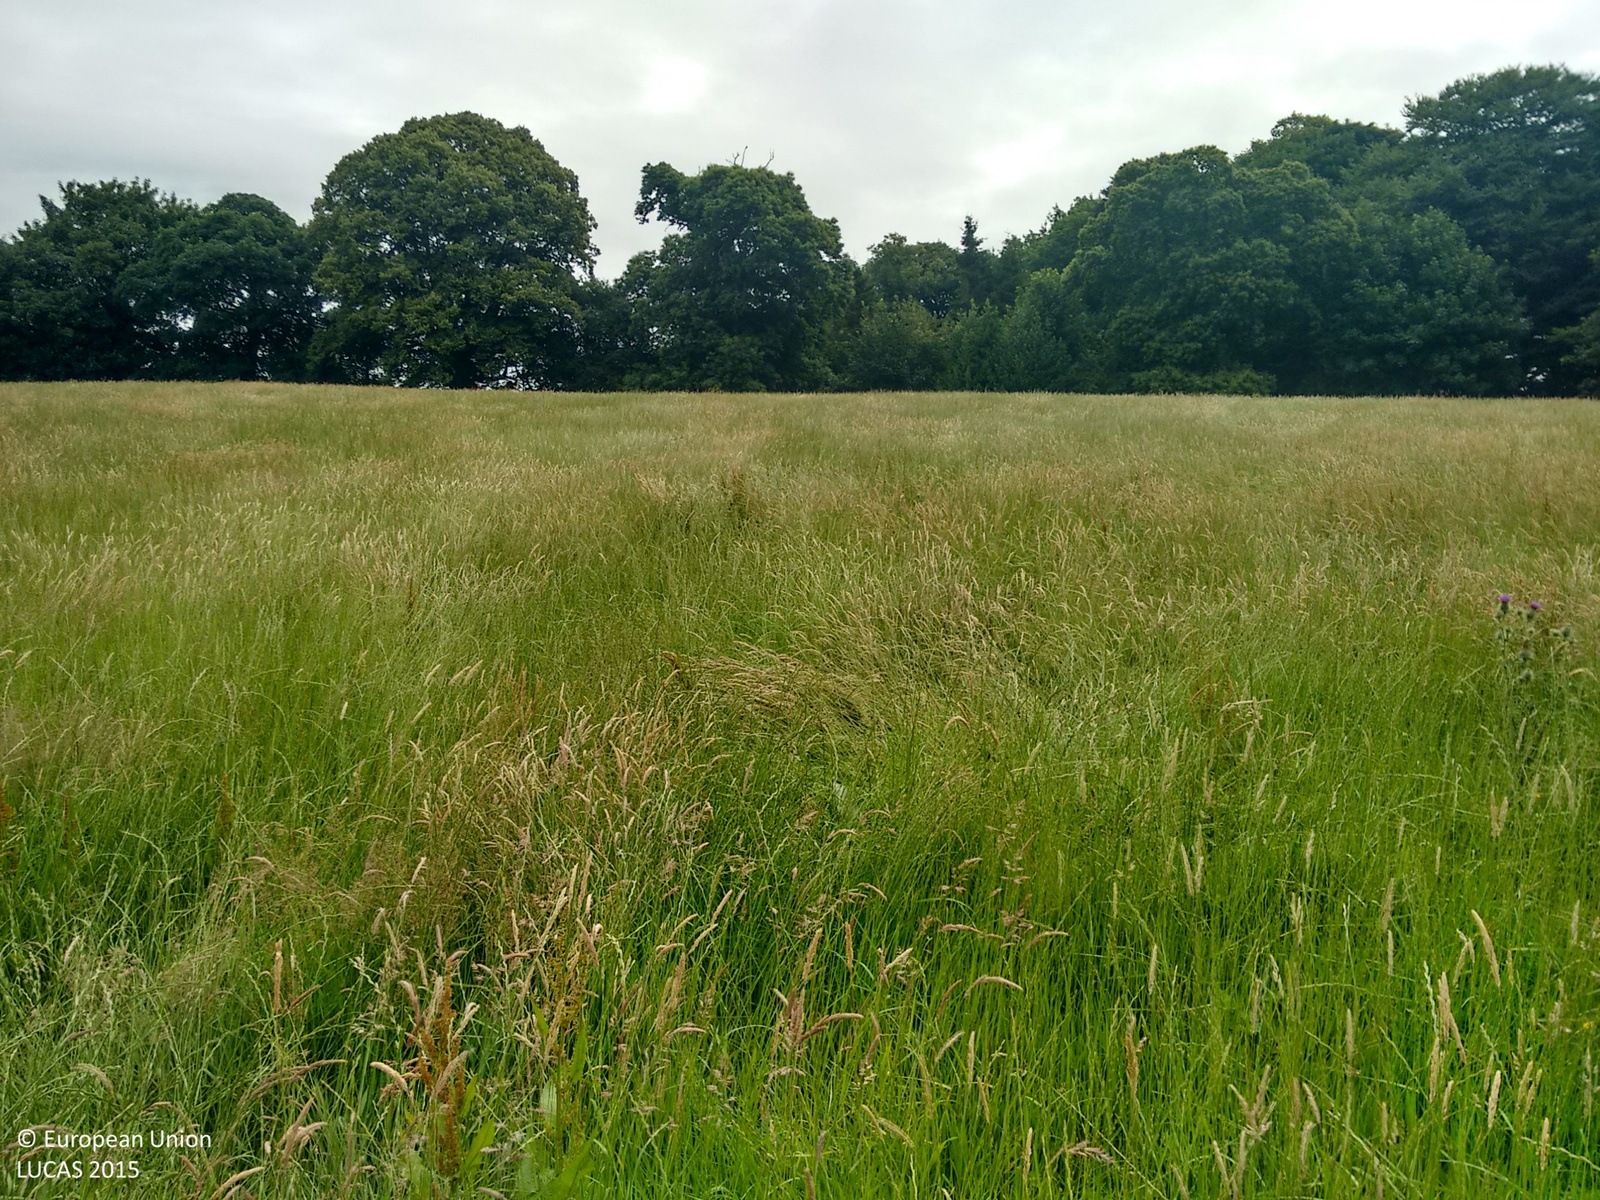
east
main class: Grassland
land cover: Grassland without tree/shrub cover
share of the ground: > 75 %
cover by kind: herbaceous plants 100 %
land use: Agriculture (excluding fallow land and kitchen gardens)
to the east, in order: Grassland without tree/shrub cover; Fences; Lines of trees; Other coniferous woodland; Grassland without tree/shrub cover; Broadleaved woodland; Grassland without tree/shrub cover; Tracks; Artificial constructions in urban areas; Broadleaved woodland
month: July
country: GB
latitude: 52.9554
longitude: -1.5577
